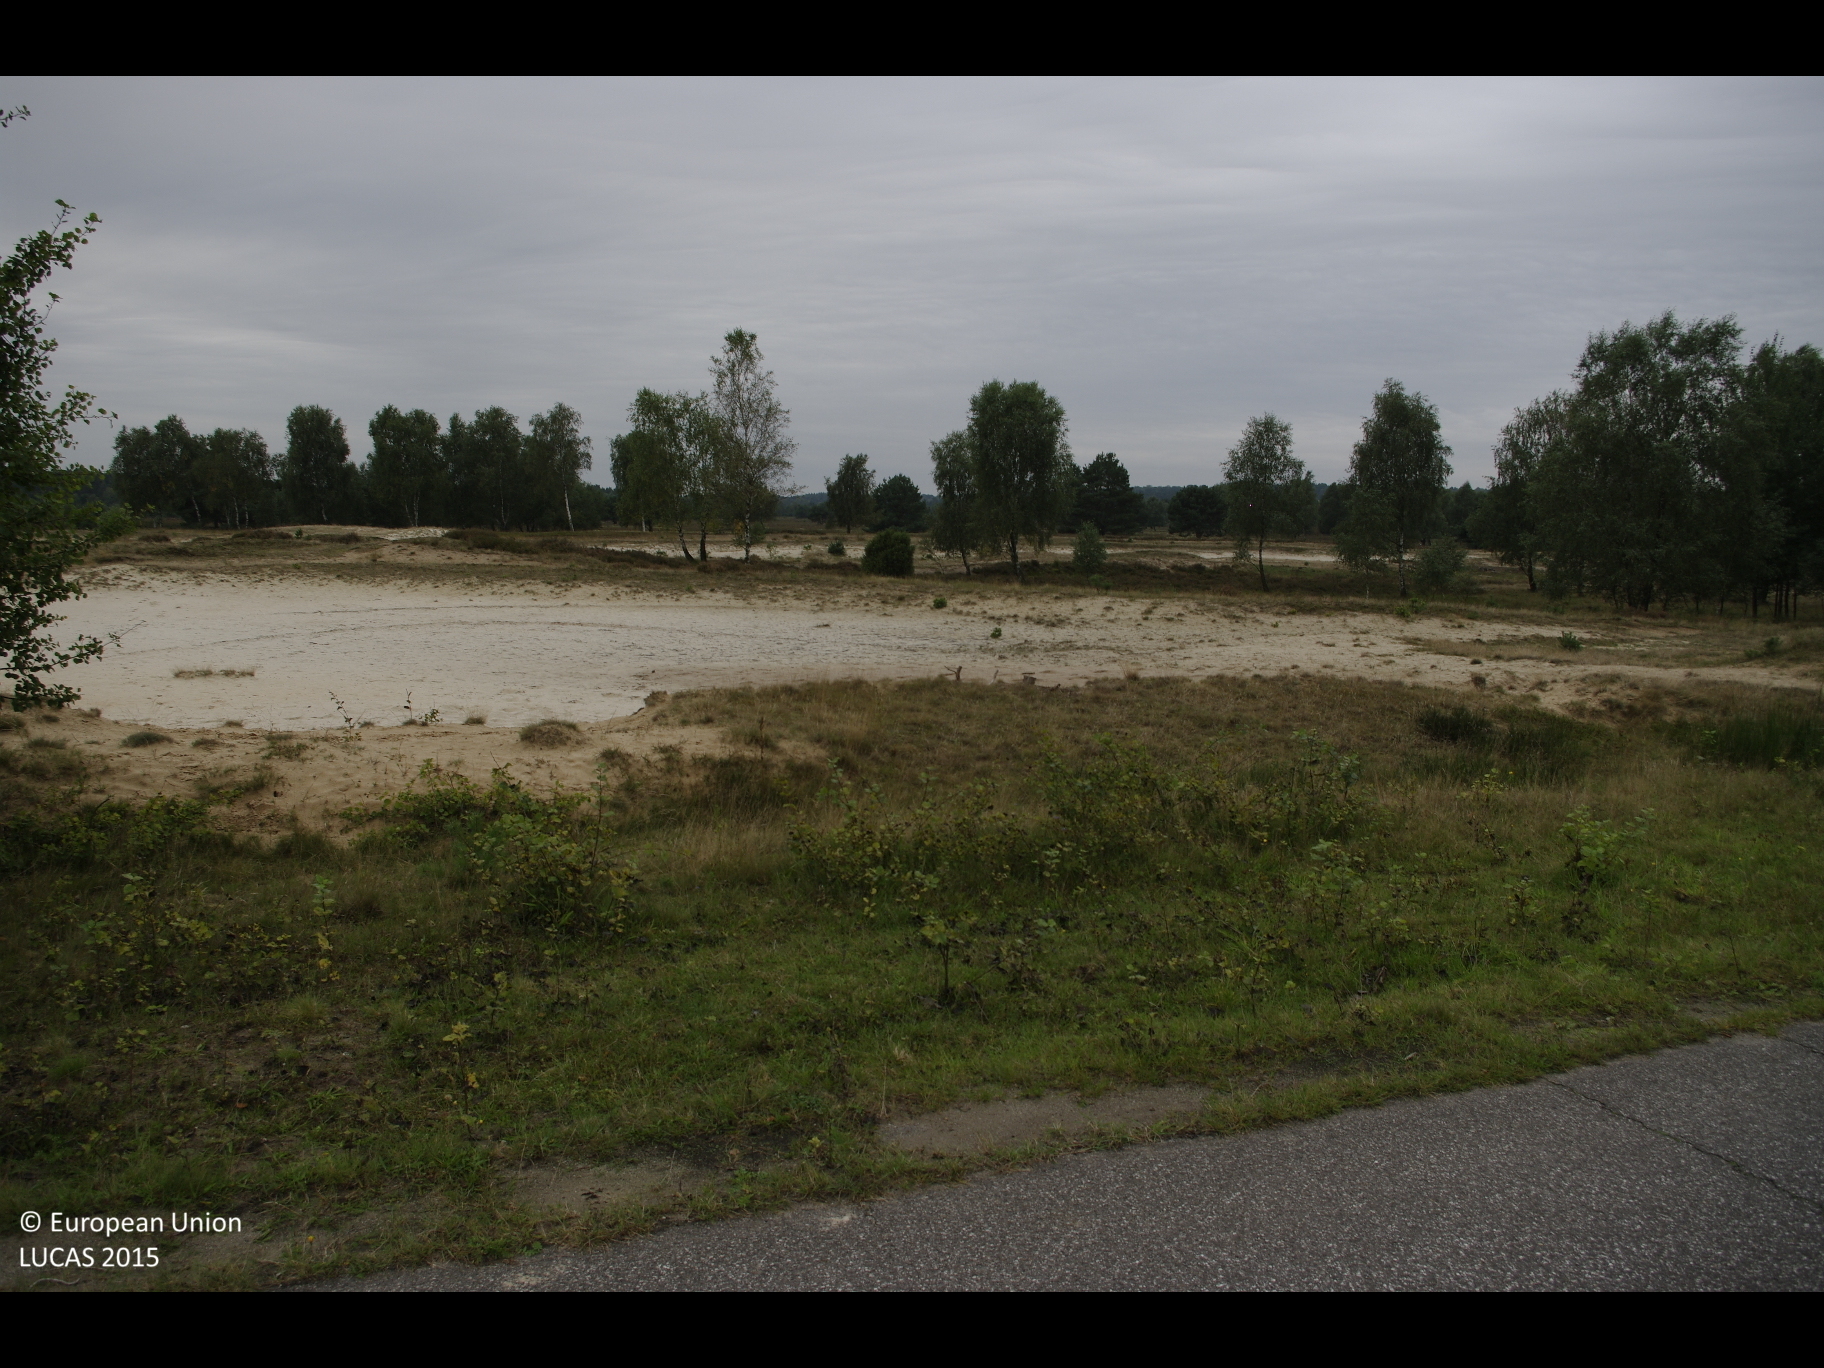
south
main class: Woodland
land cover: Pine dominated coniferous woodland
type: hemiboreal forest and nemoral coniferous forest and mixed broadleaved-coniferous forest
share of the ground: 50 - 75 %
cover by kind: coniferous forest trees 60 %, shrubs 40 %
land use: Forestry
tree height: > 5 m
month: September
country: DE
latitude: 53.1323
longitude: 9.9253
